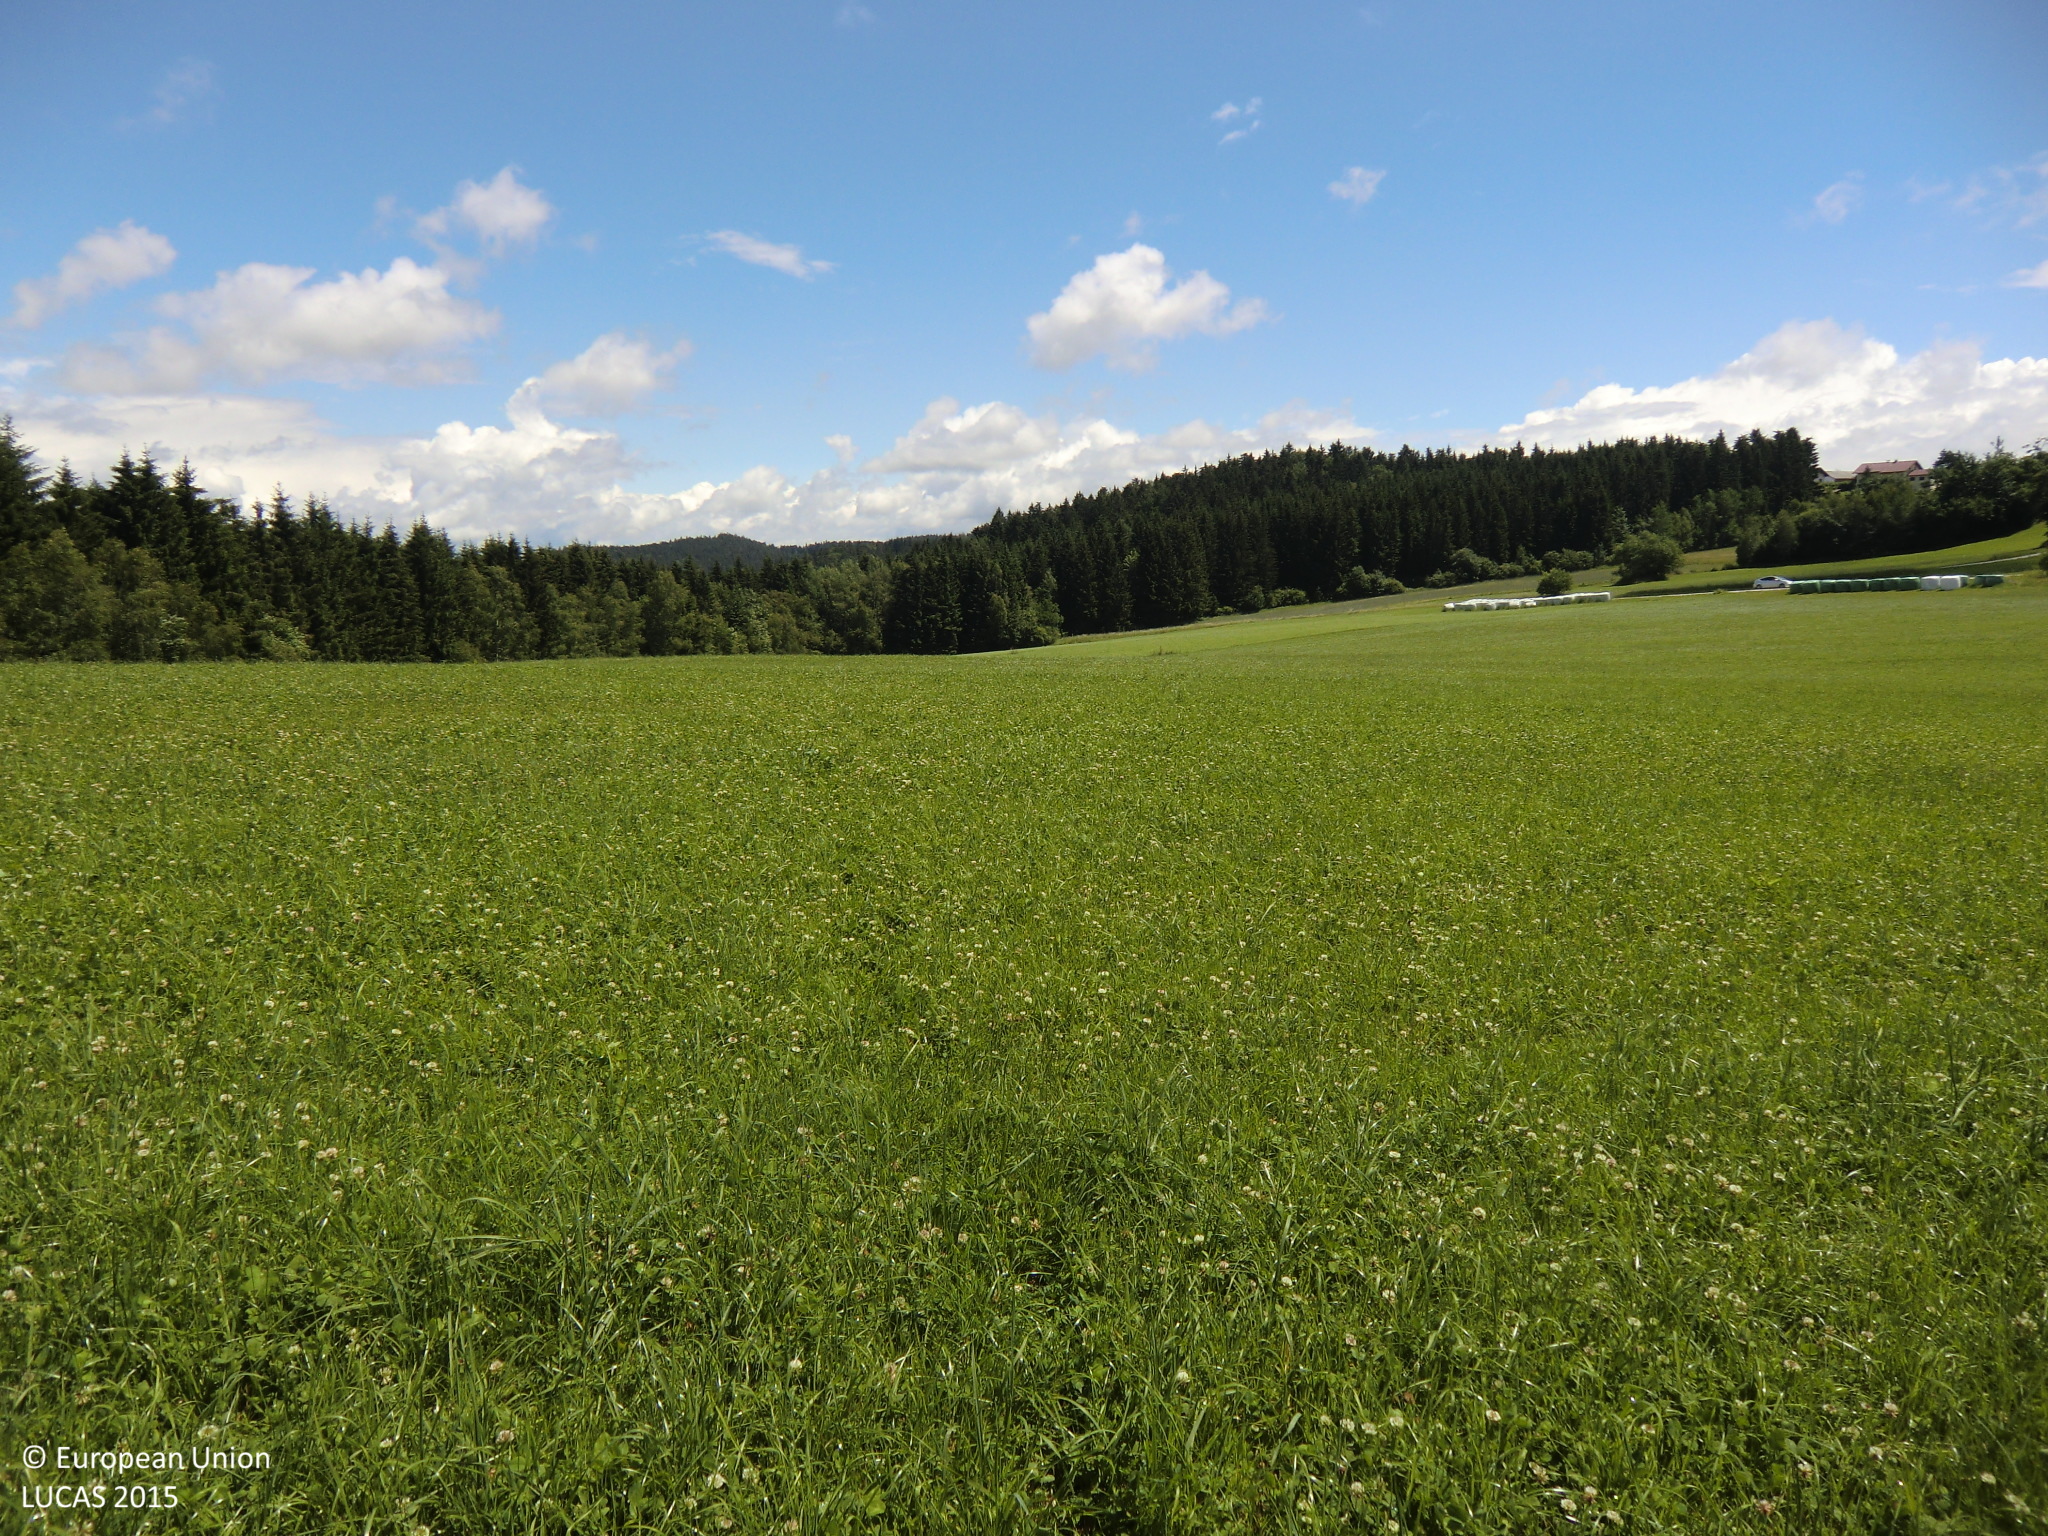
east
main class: Cropland
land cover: Rye
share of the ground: > 75 %
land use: Agriculture (excluding fallow land and kitchen gardens)
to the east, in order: Rye; Temporary grasslands; Spruce dominated coniferous woodland
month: June
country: AT
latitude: 48.4315
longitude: 15.0700
